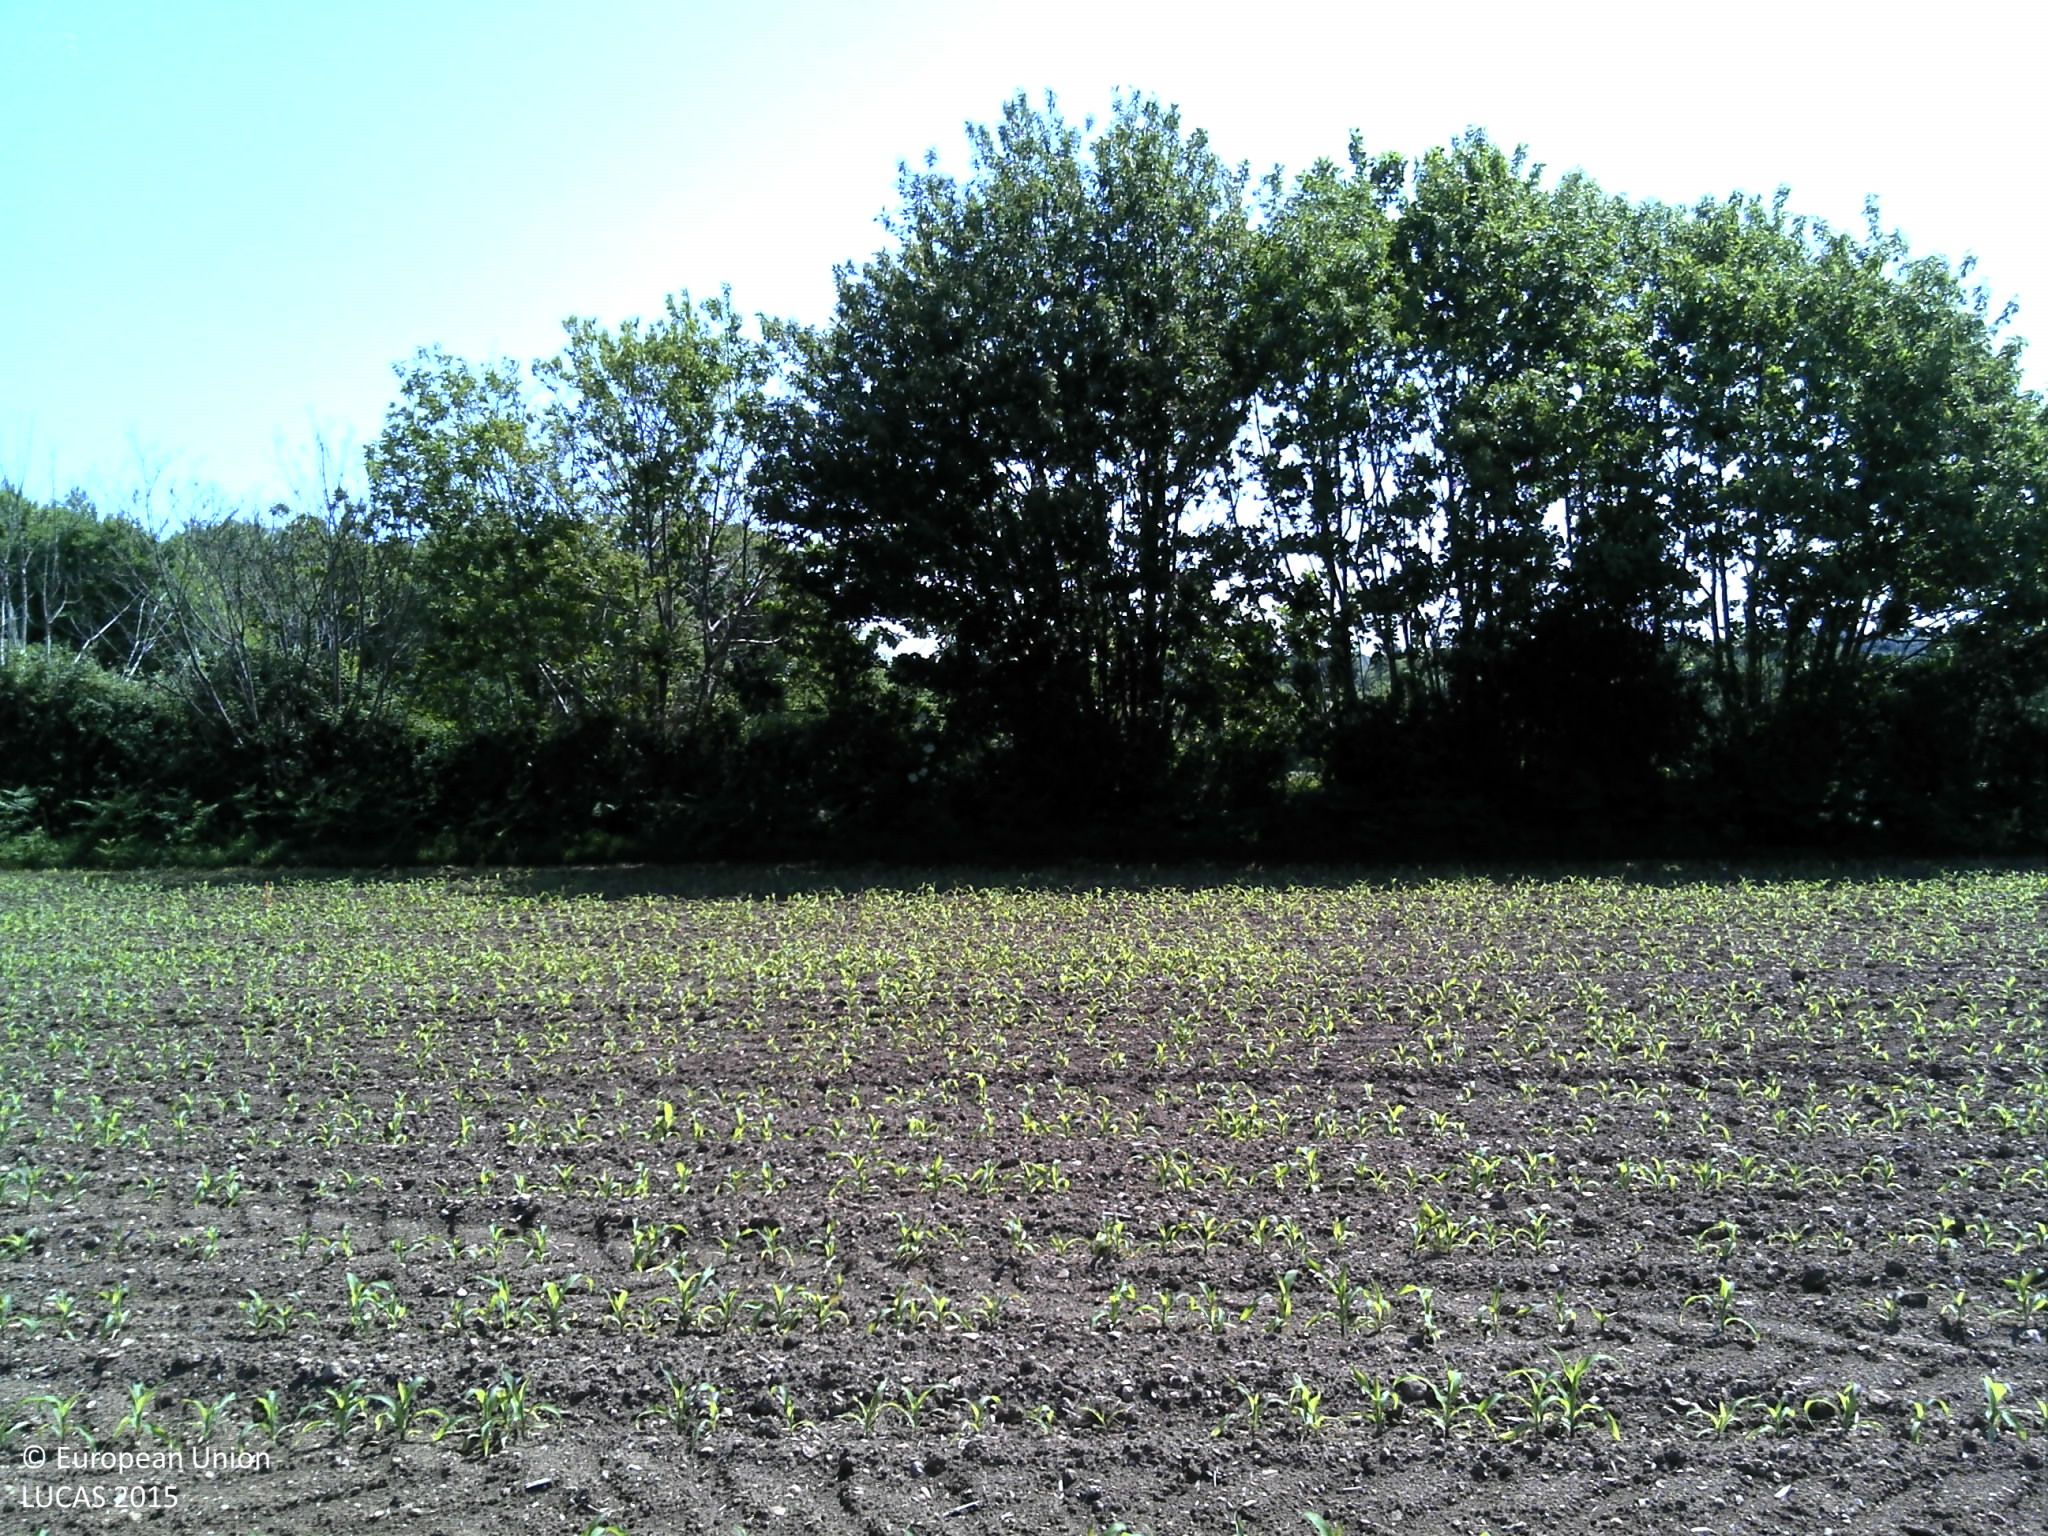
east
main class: Cropland
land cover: Maize
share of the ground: 25 - 50 %
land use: Agriculture (excluding fallow land and kitchen gardens)
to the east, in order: Maize; Abandoned hedges; Grass margins; Maize
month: June
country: FR
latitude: 47.9147
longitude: -4.0971
